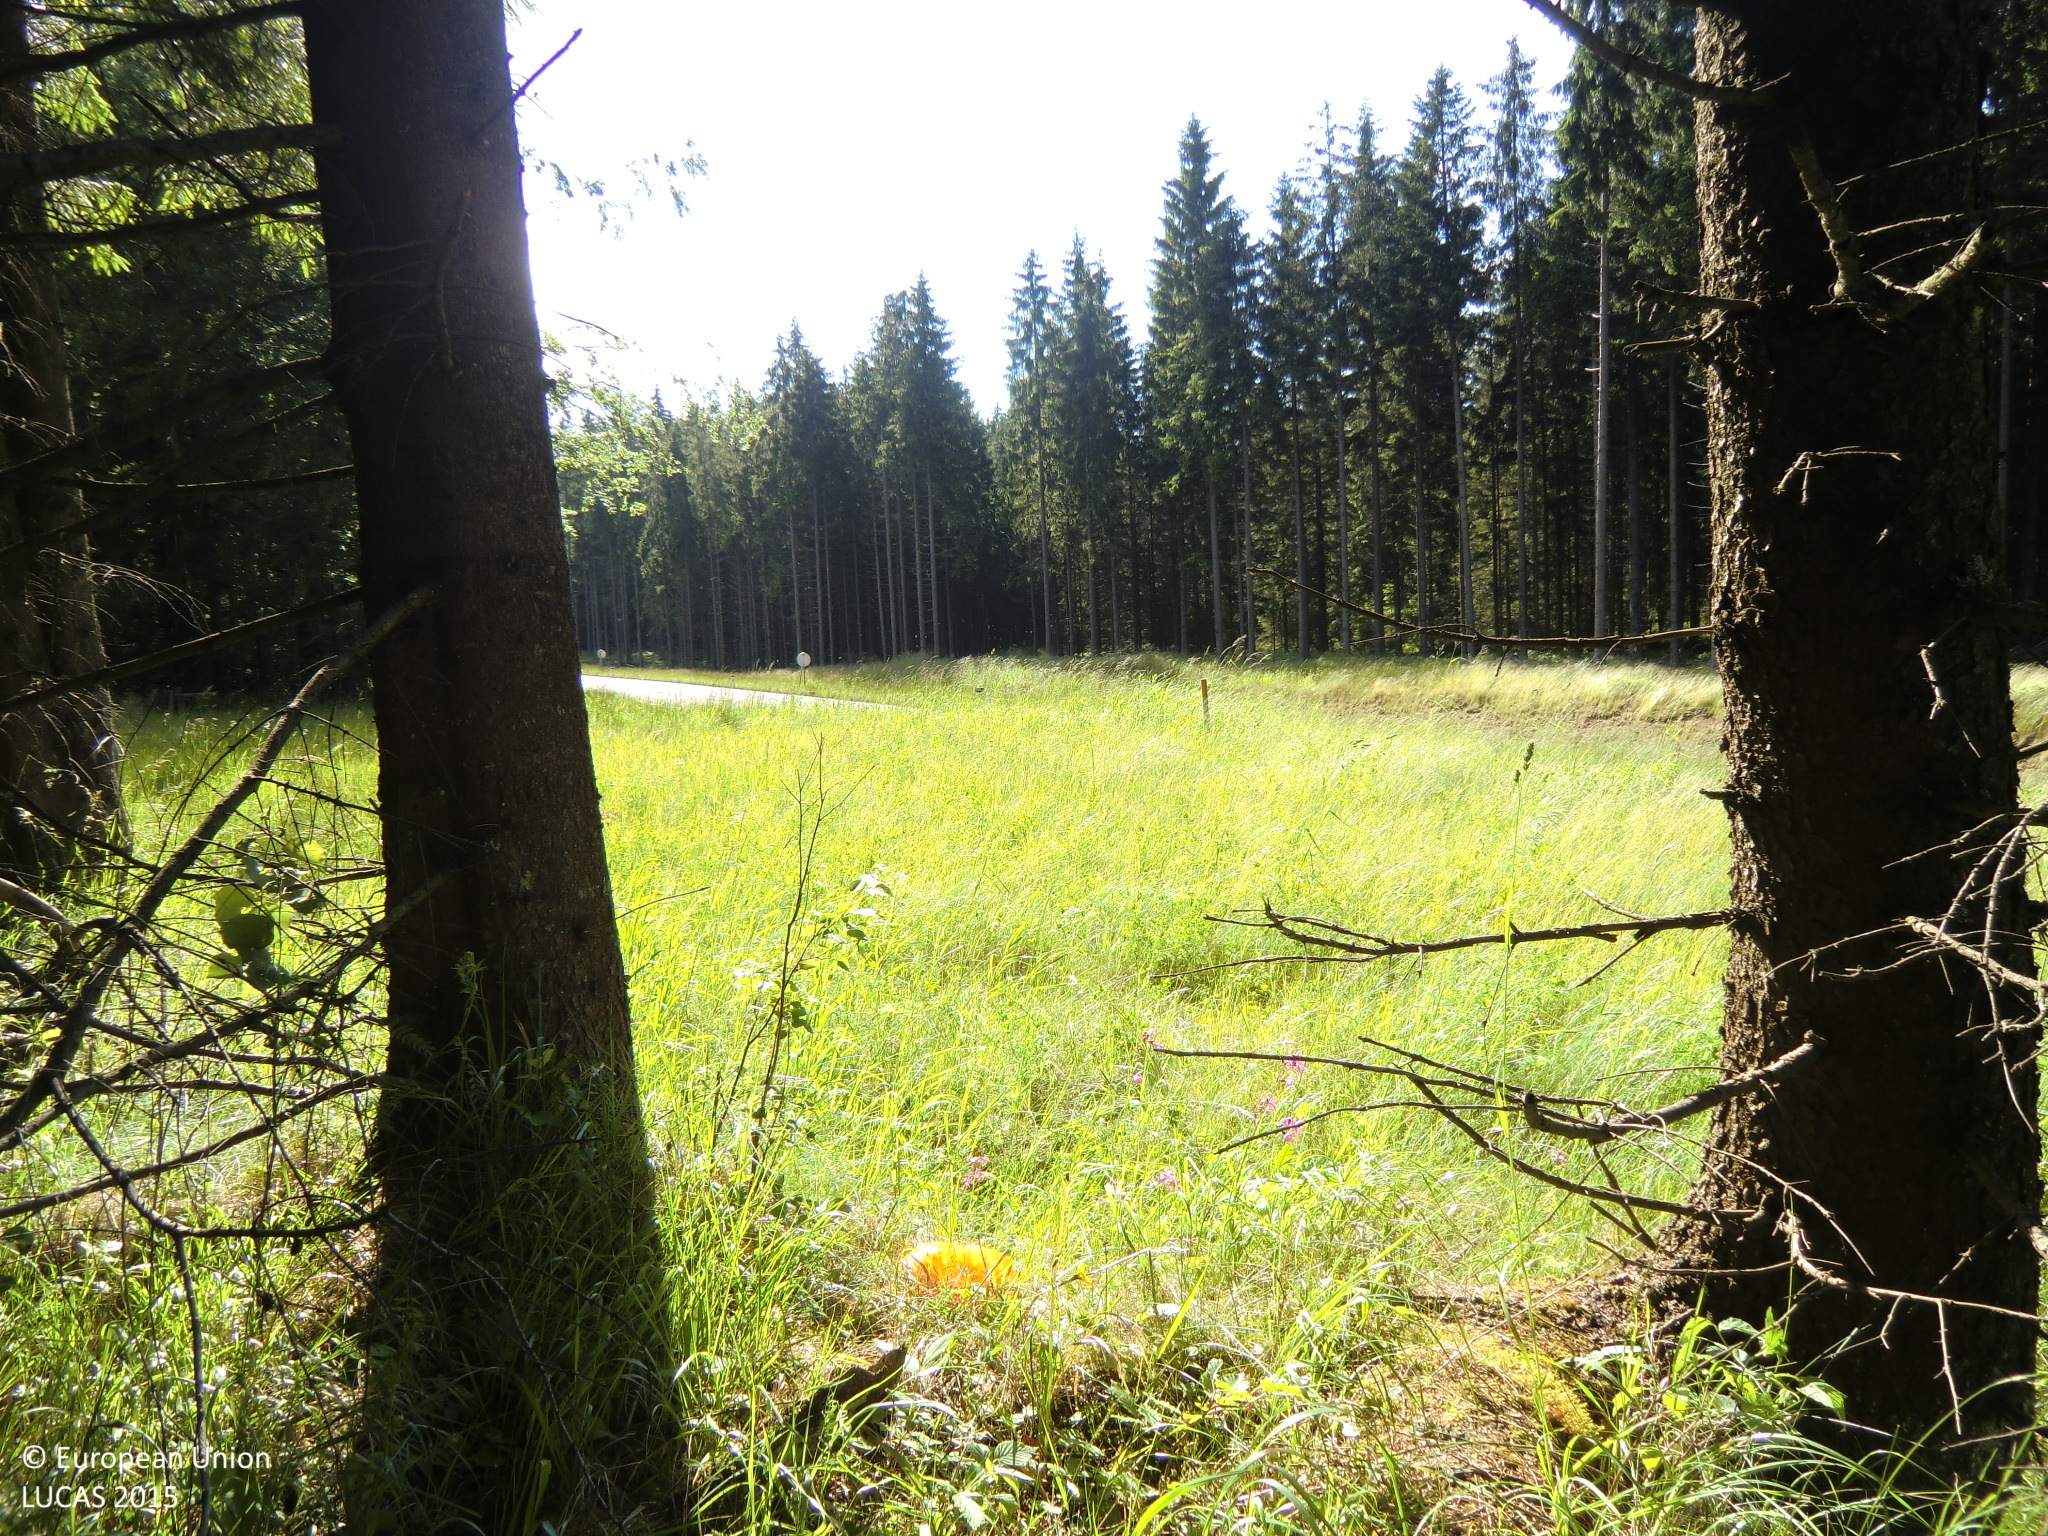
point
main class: Woodland
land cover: Spruce dominated coniferous woodland
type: hemiboreal forest and nemoral coniferous forest and mixed broadleaved-coniferous forest
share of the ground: > 75 %
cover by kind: coniferous forest trees 80 %, herbaceous plants 20 %
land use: Forestry
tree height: > 5 m
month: June
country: AT
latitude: 48.5558
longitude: 14.7025
